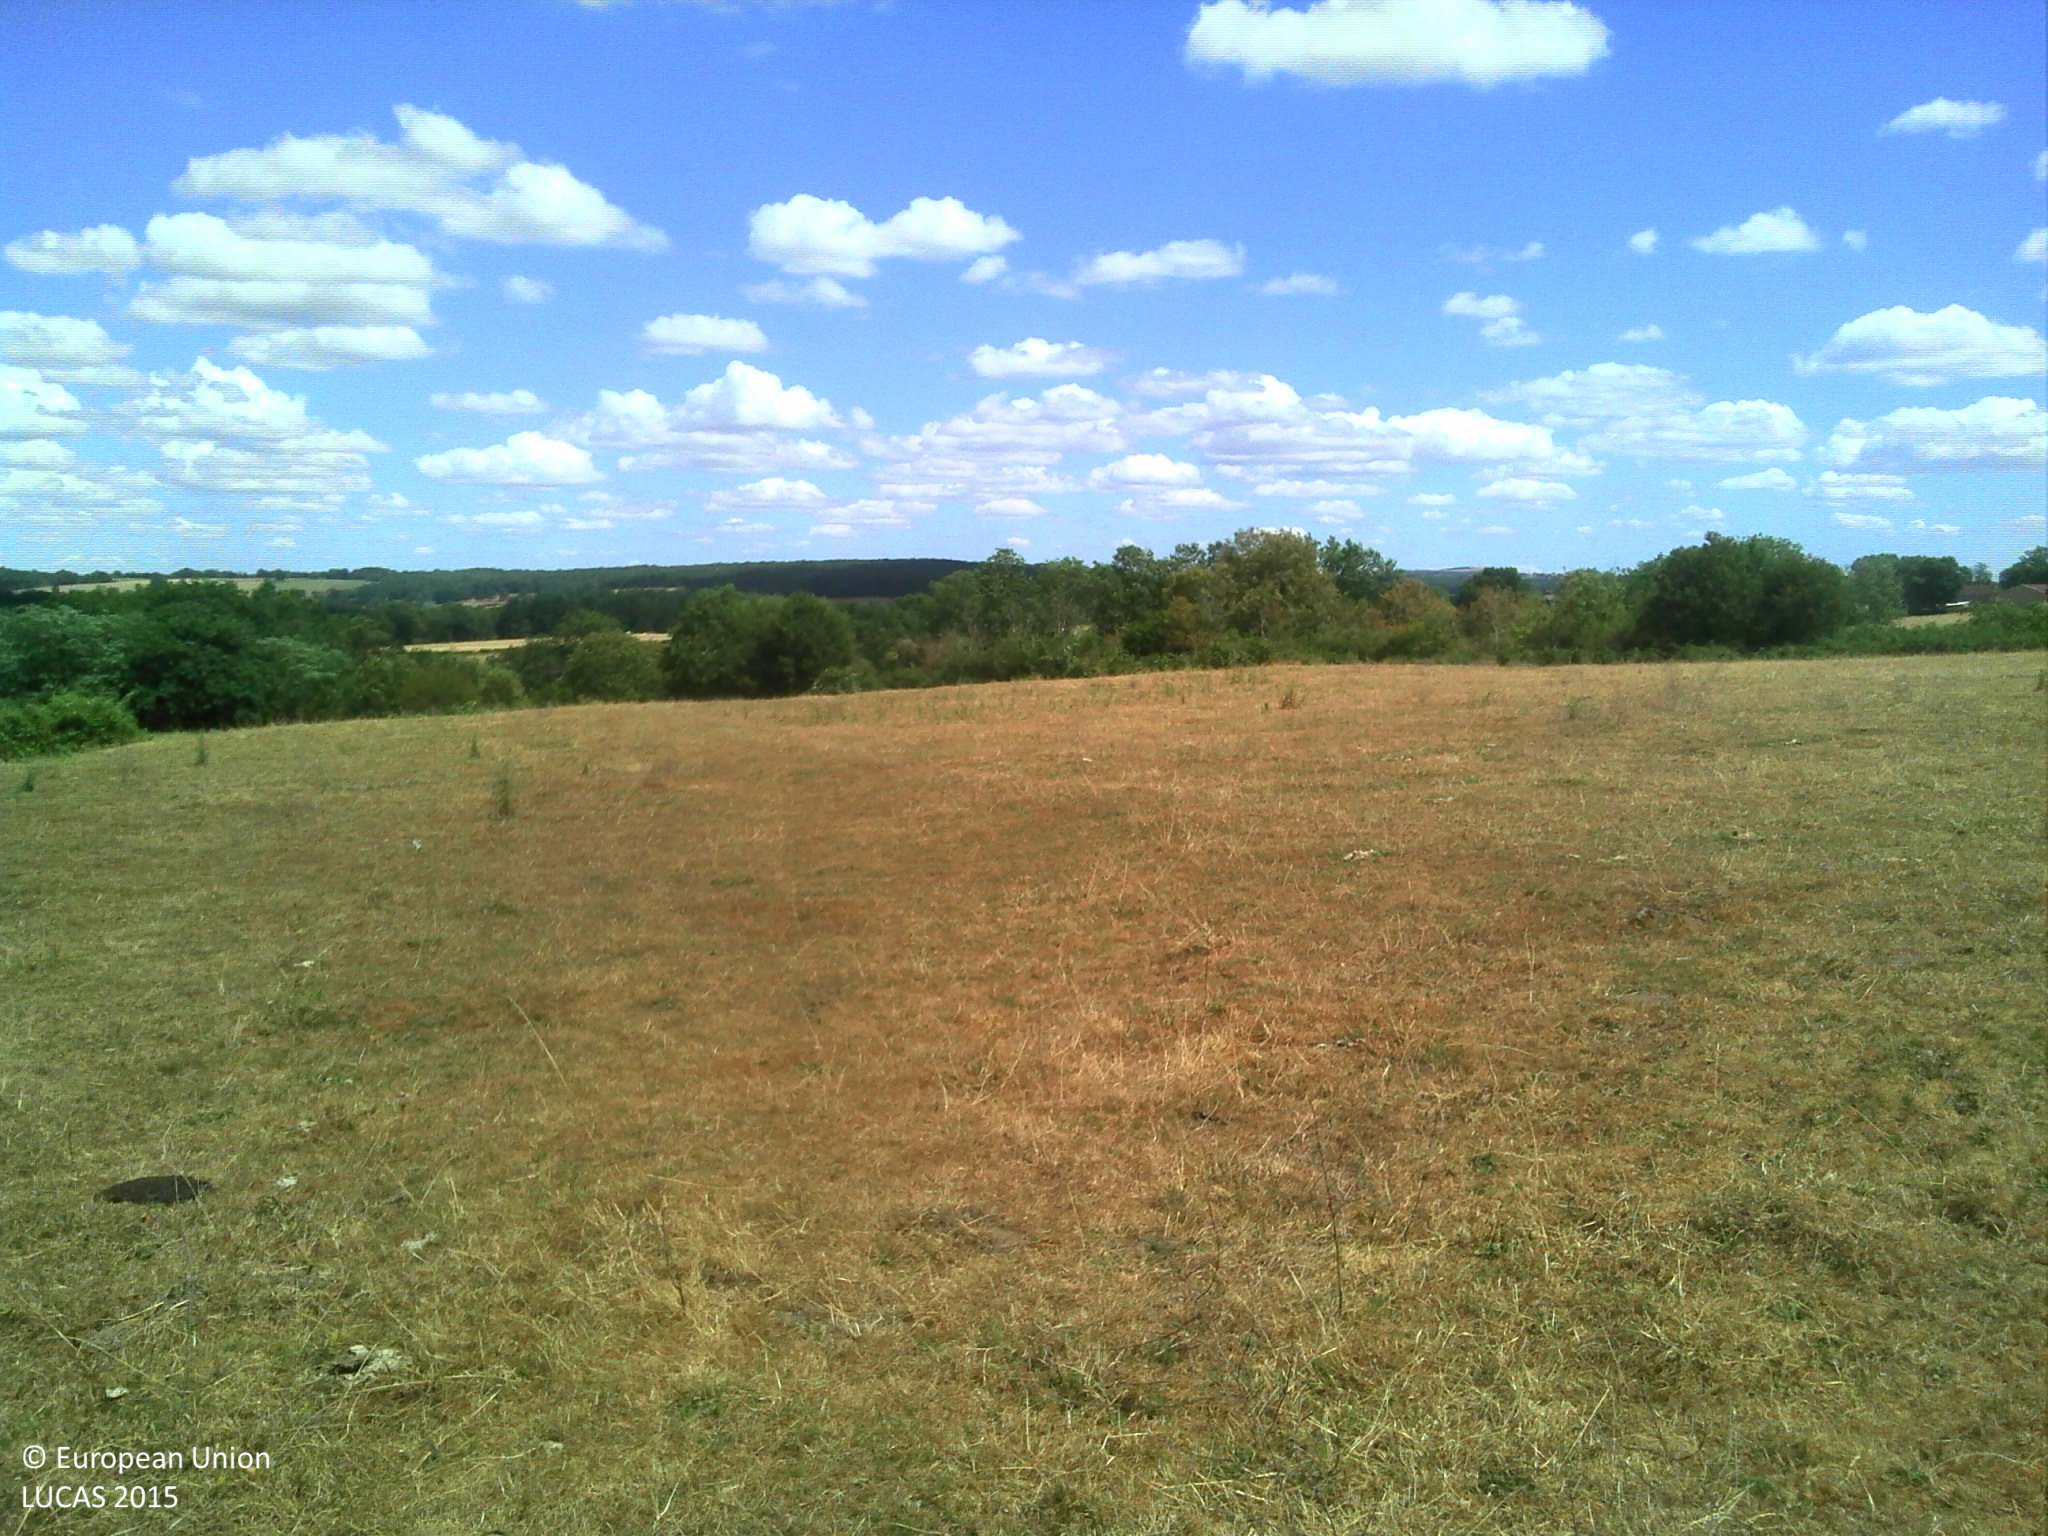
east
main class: Grassland
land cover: Grassland without tree/shrub cover
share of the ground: > 75 %
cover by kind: herbaceous plants 100 %
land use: Agriculture (excluding fallow land and kitchen gardens)
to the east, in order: Grassland without tree/shrub cover; Fences; Abandoned hedges; Grass margins; Paved roads, cycling and walking lanes; Grass margins; Broadleaved woodland; Fences; Grassland without tree/shrub cover
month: July
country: FR
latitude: 46.9315
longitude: 4.4970
